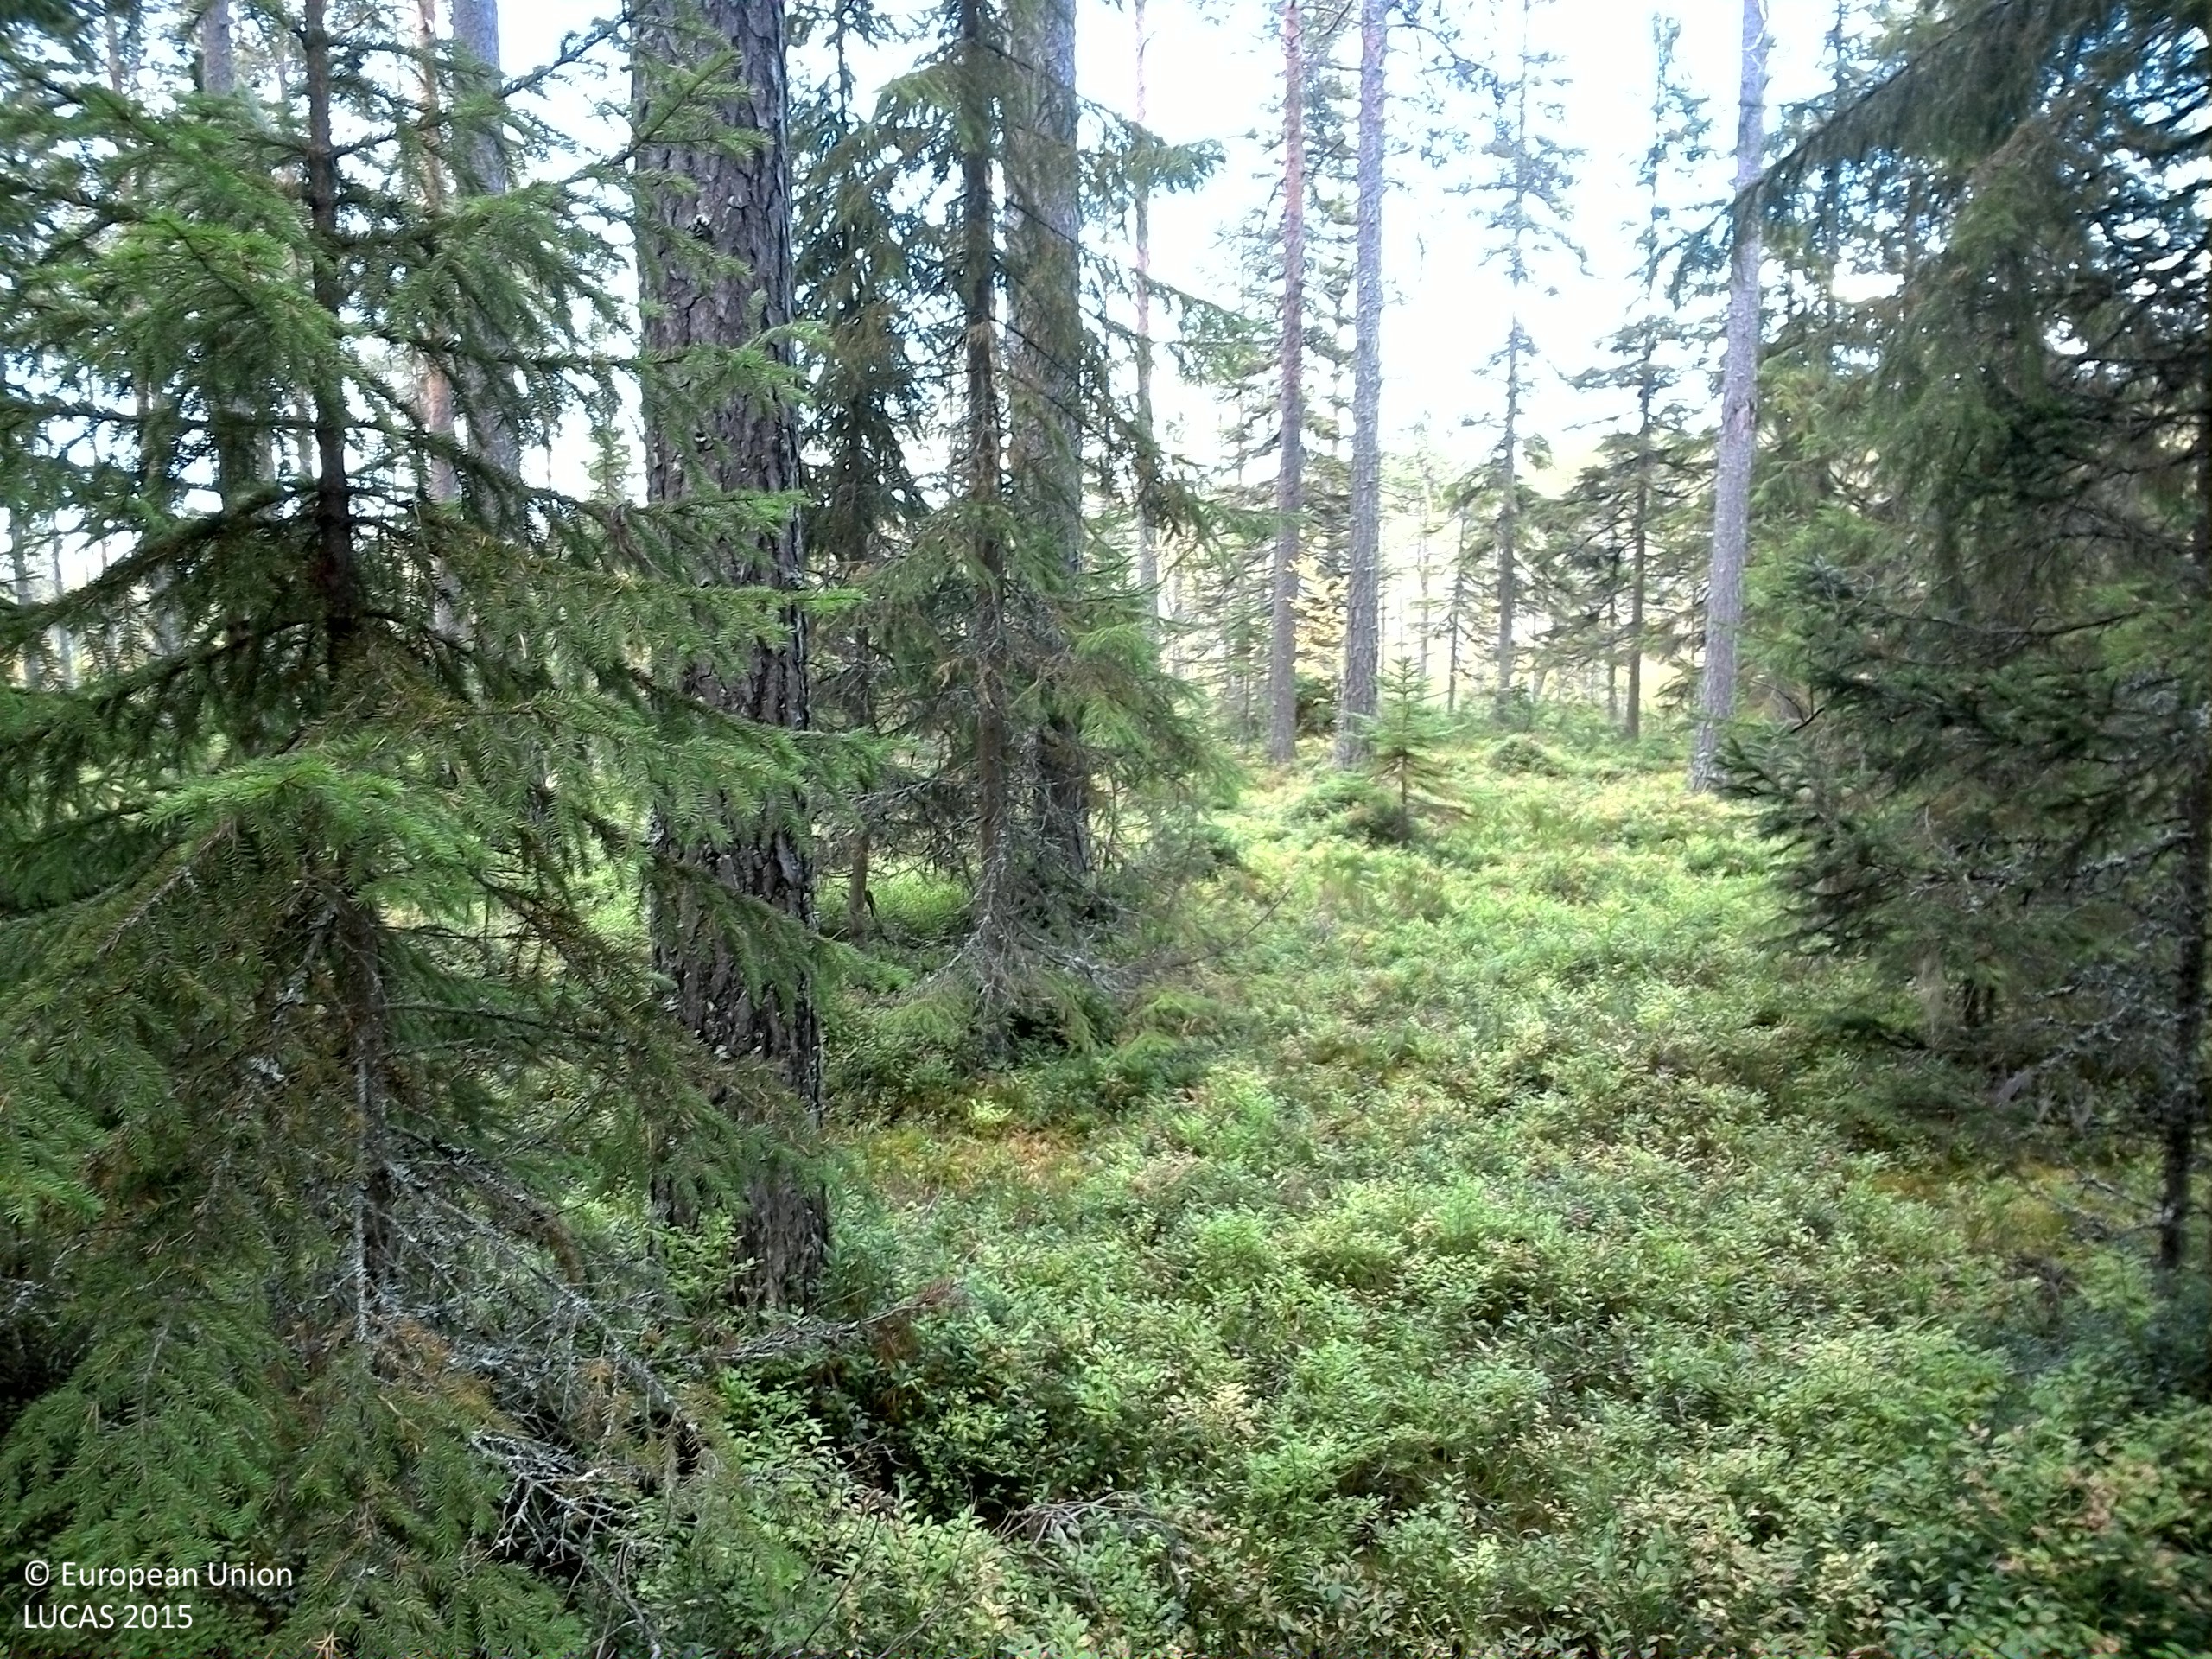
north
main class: Woodland
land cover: Other coniferous woodland
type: boreal forest
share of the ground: 50 - 75 %
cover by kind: coniferous forest trees 65 %, shrubs 30 %, lichens and mosses 5 %
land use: Forestry
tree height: > 5 m
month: September
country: SE
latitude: 61.3223
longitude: 15.4207
